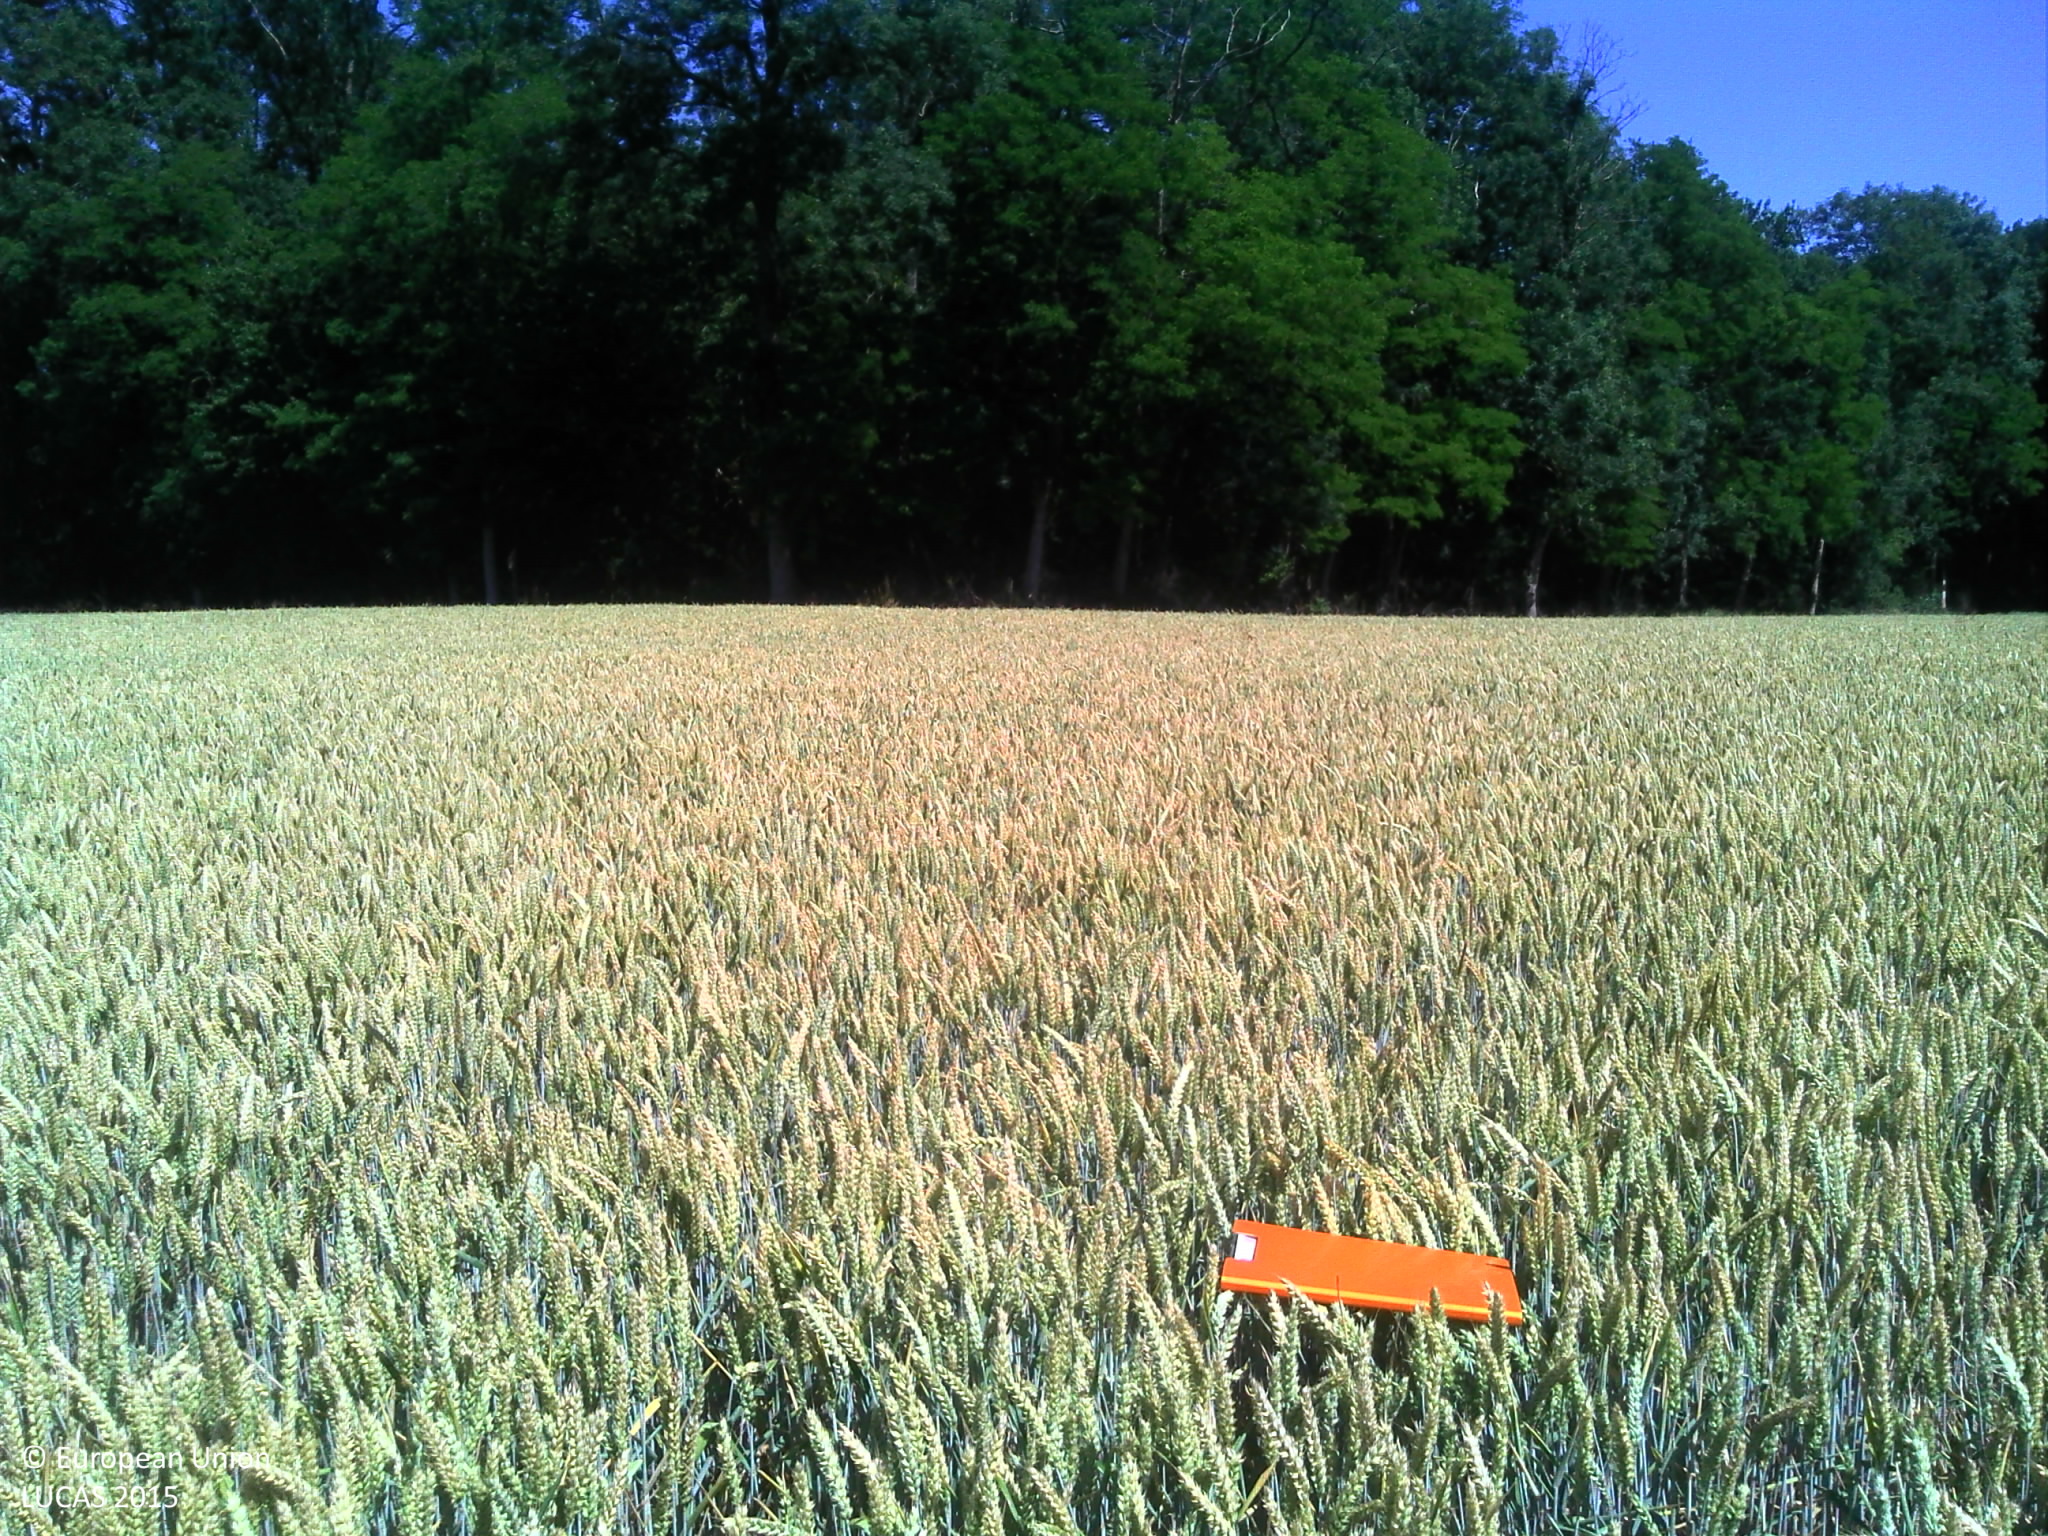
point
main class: Cropland
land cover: Common wheat
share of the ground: > 75 %
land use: Agriculture (excluding fallow land and kitchen gardens)
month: June
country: FR
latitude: 48.9641
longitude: 3.3956
